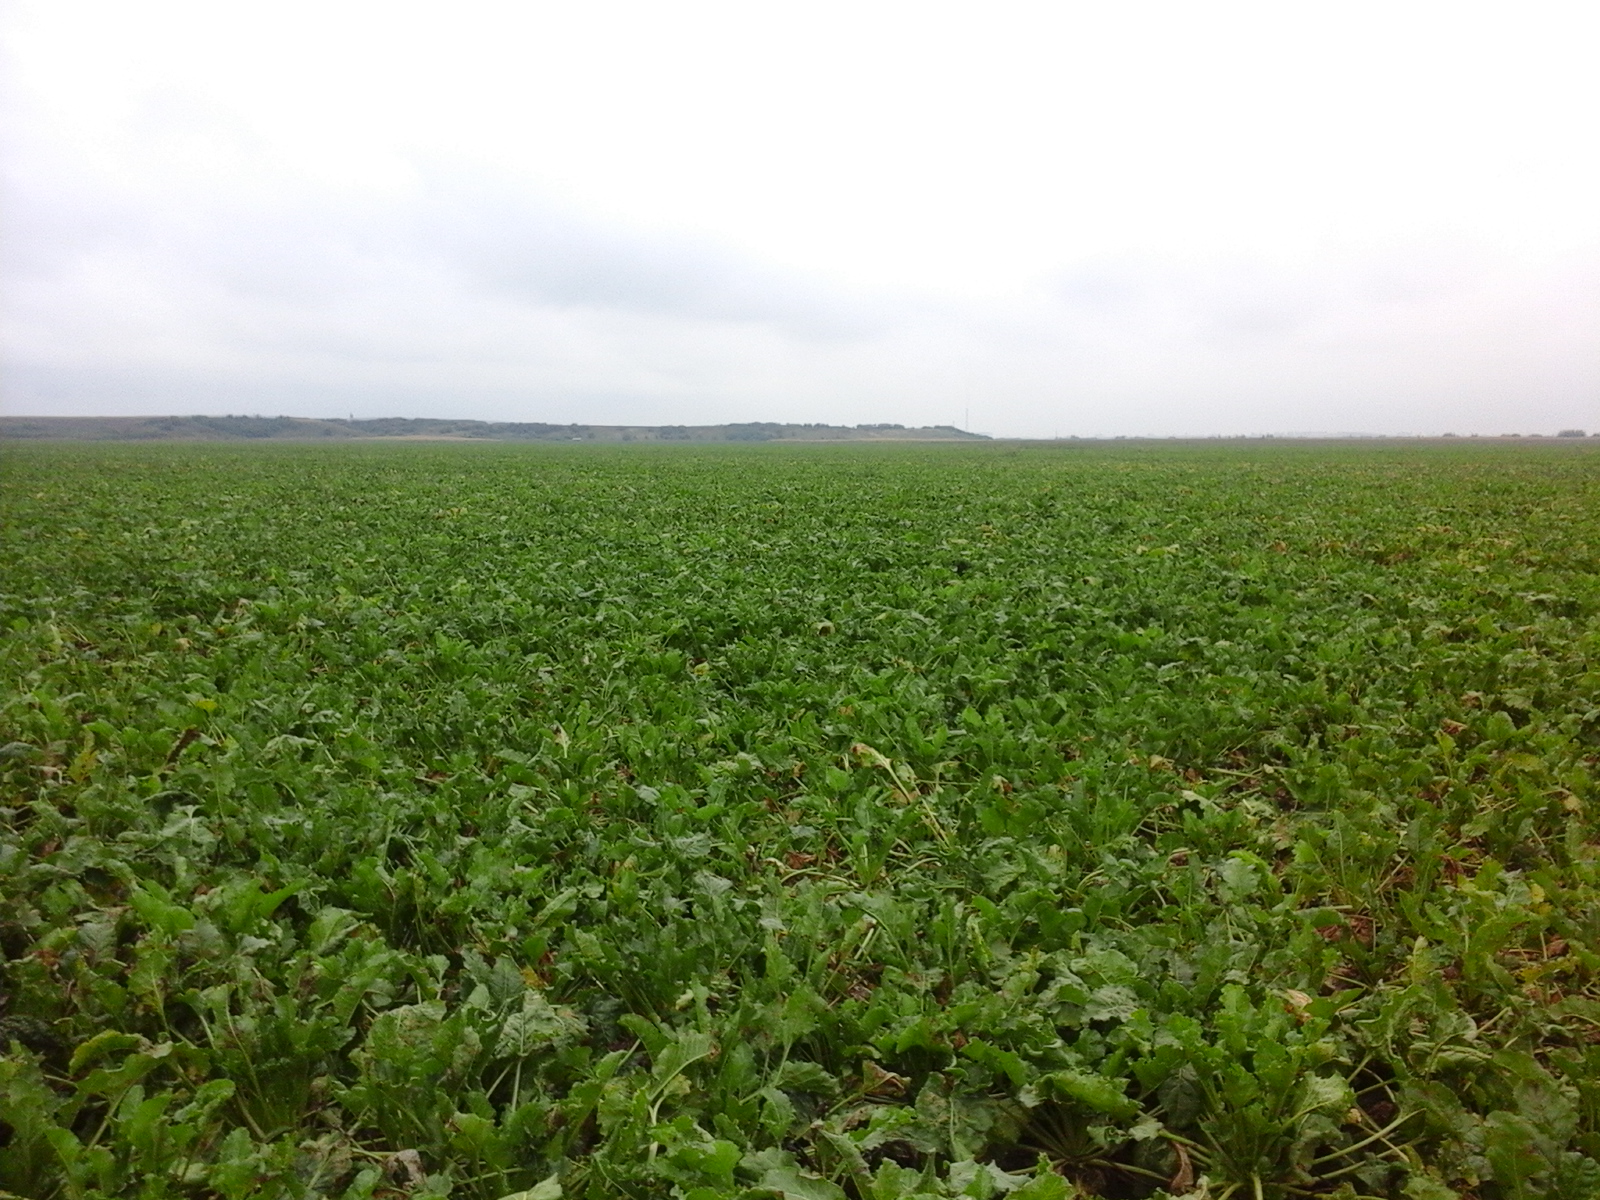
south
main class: Cropland
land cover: Sugar beet
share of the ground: > 75 %
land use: Agriculture (excluding fallow land and kitchen gardens)
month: September
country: RO
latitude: 47.1604
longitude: 21.8781
